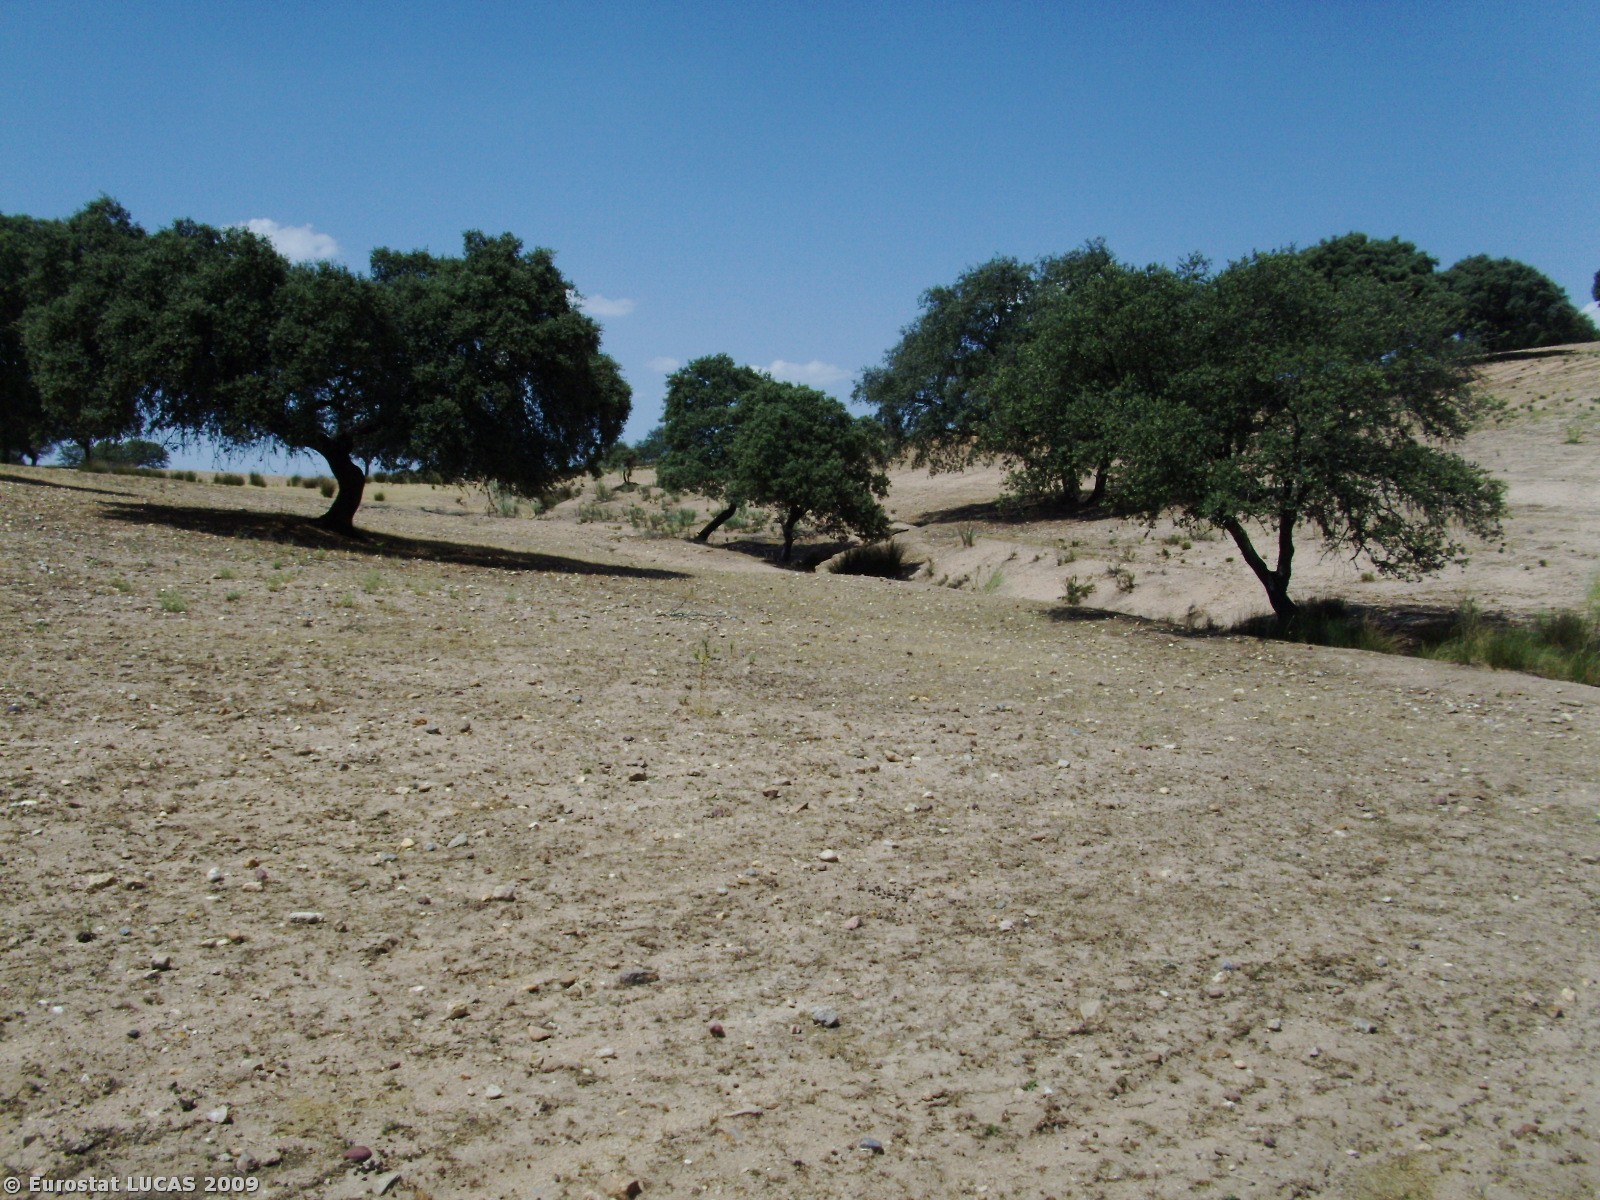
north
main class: Bare land
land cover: Bare land
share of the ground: > 75 %
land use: Fallow land
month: June
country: PT
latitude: 39.7602
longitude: -7.1432
